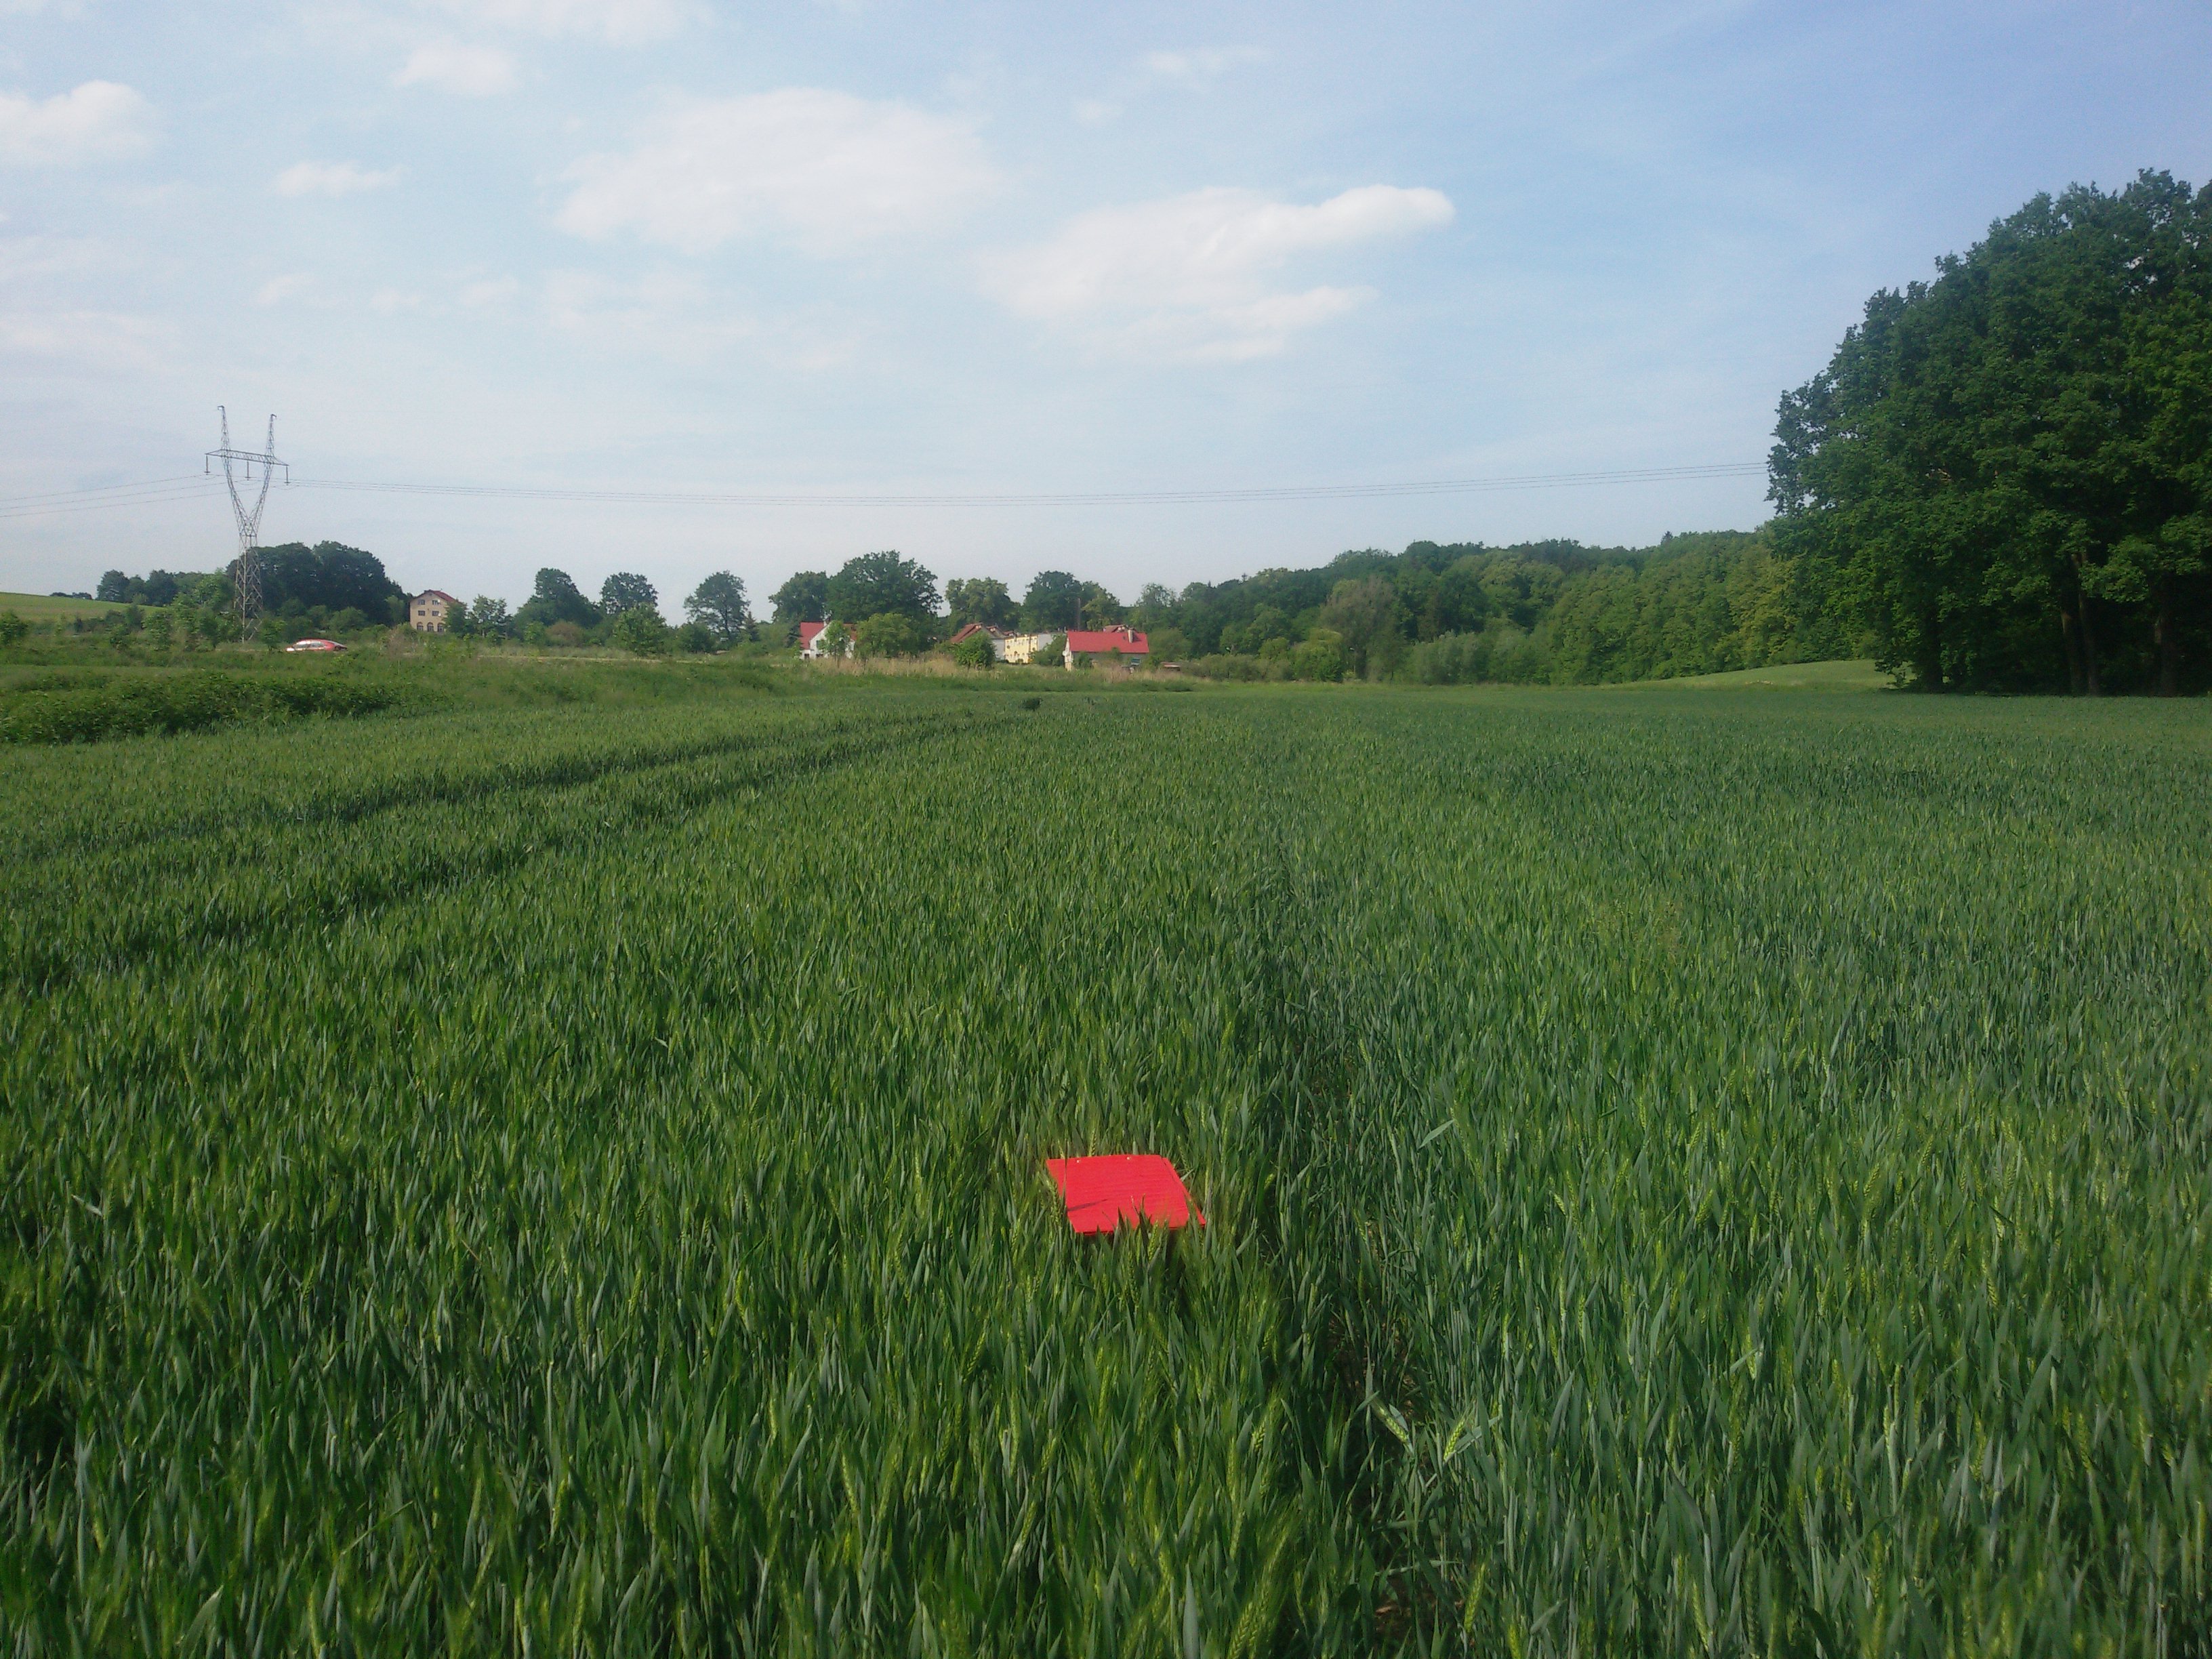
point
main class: Cropland
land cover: Triticale
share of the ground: > 75 %
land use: Agriculture (excluding fallow land and kitchen gardens)
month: May
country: PL
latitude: 50.5151
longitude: 17.2176
